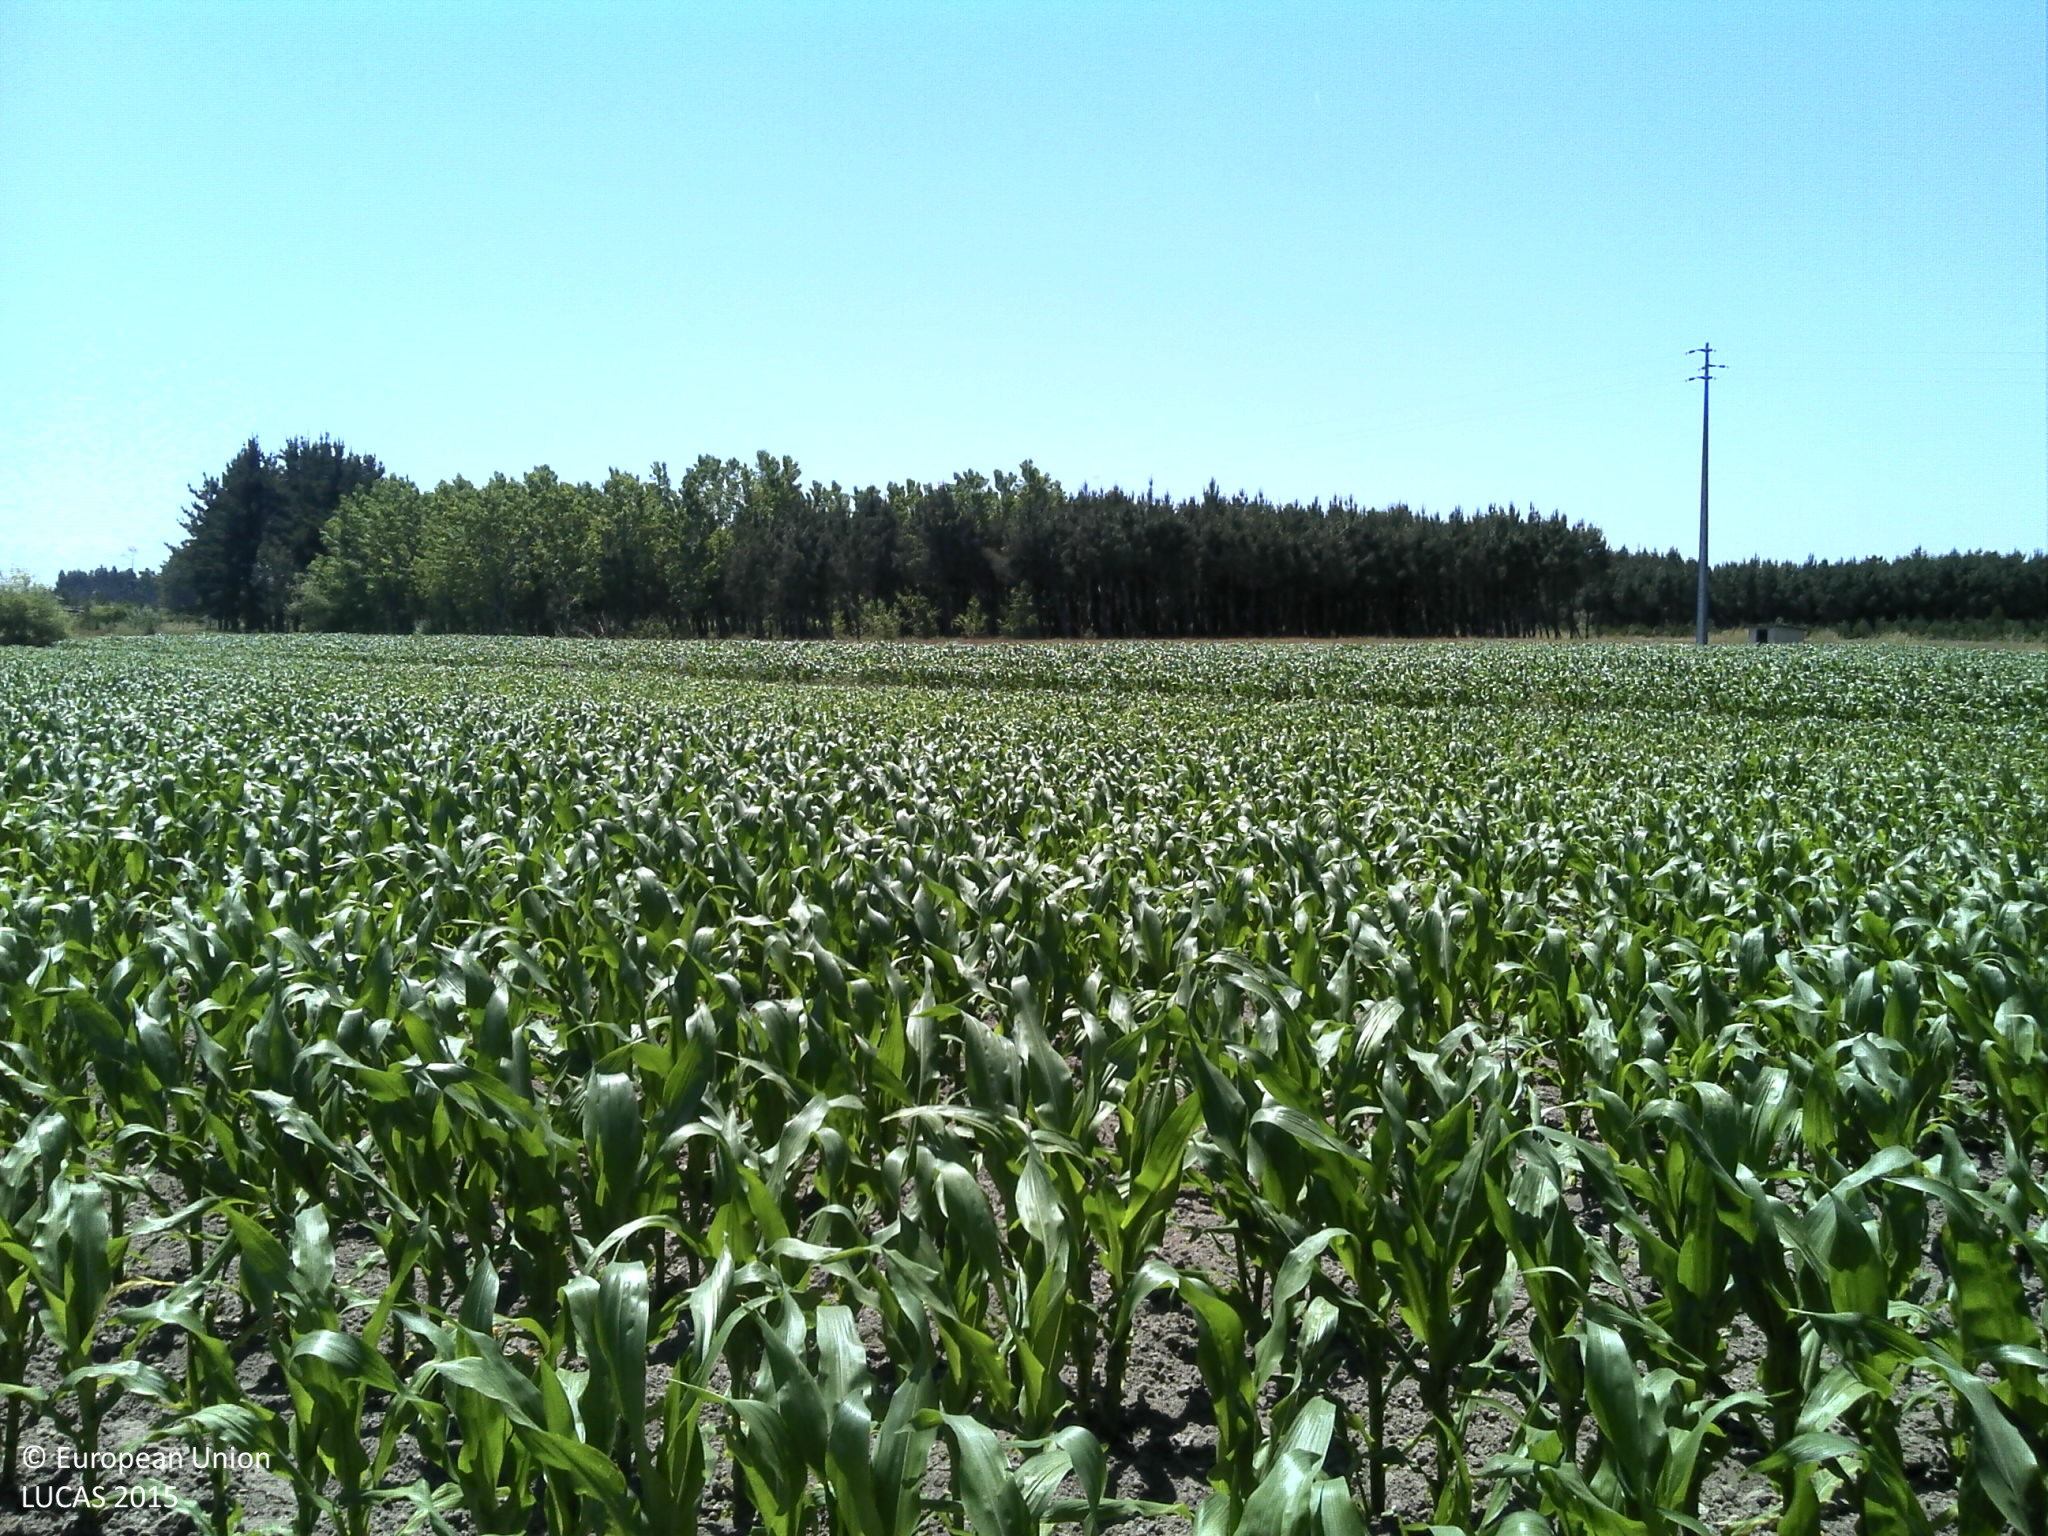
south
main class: Cropland
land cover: Maize
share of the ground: 10 - 25 %
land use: Agriculture (excluding fallow land and kitchen gardens)
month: May
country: PT
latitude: 40.4651
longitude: -8.6214
